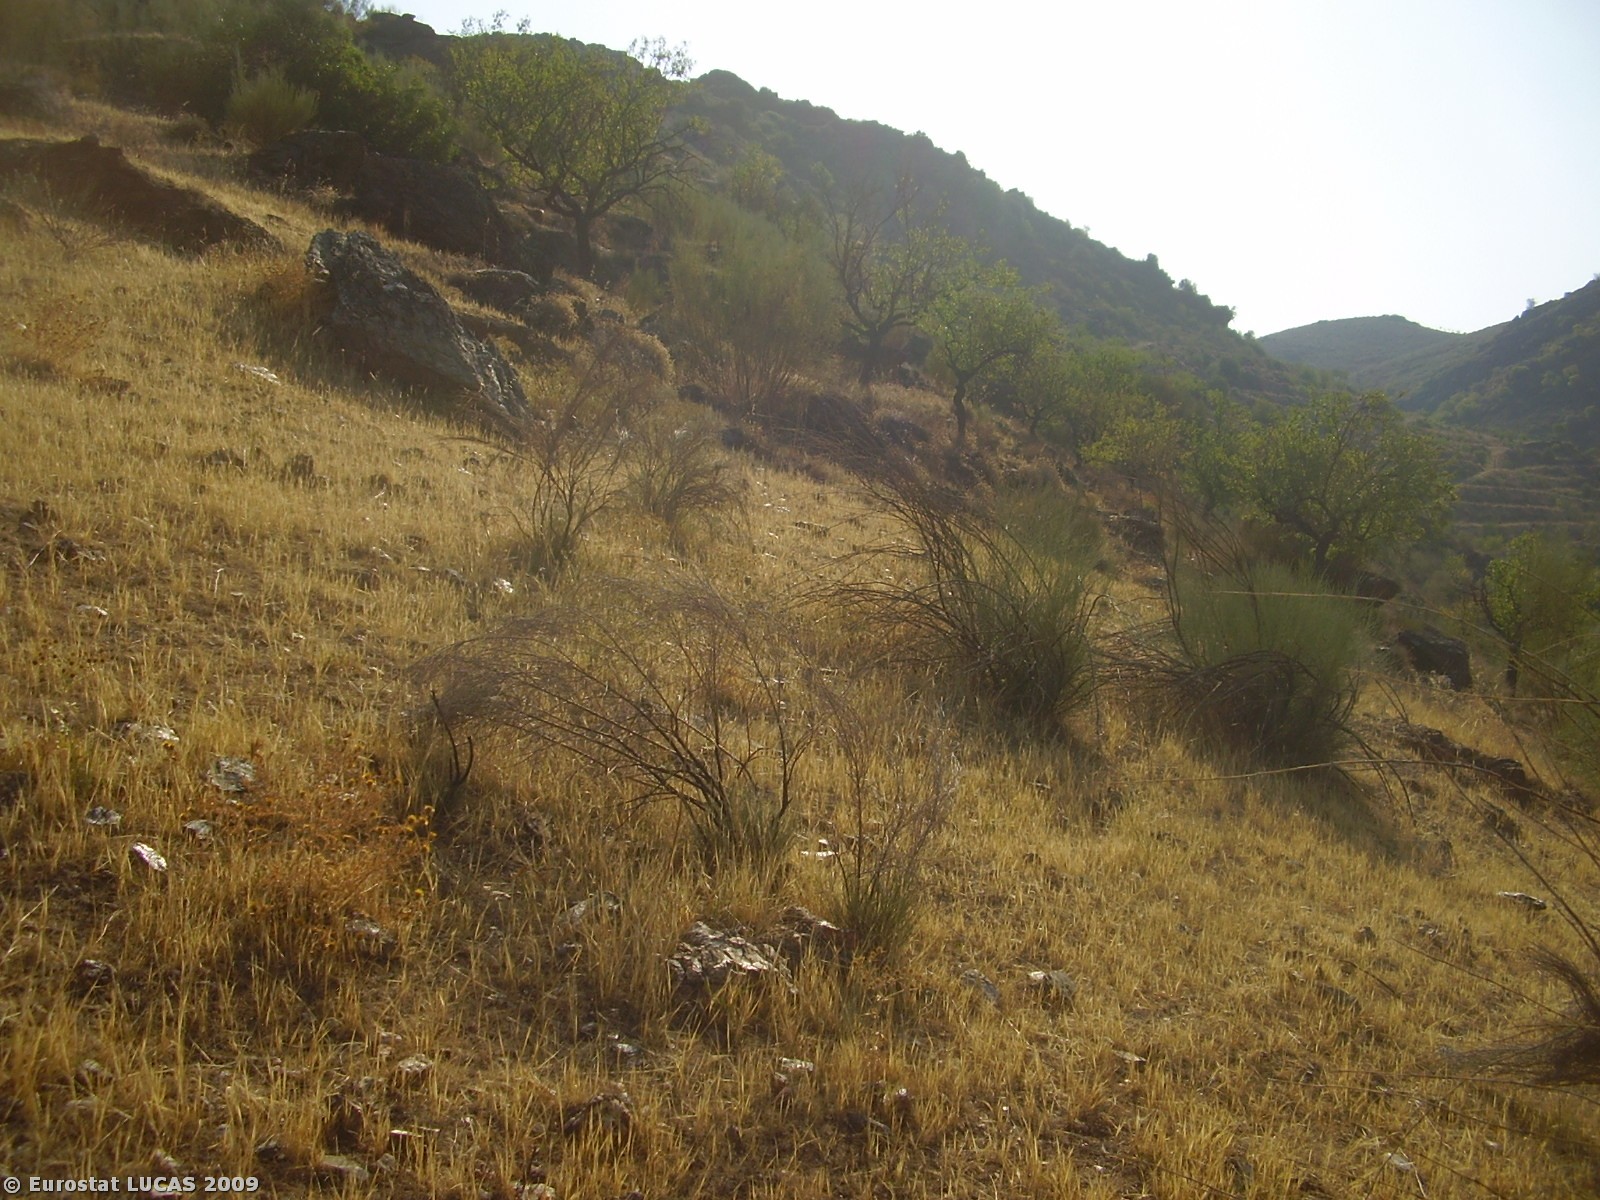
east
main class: Grassland
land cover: Spontaneously vegetated surfaces
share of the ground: > 75 %
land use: Fallow land
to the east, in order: Spontaneously vegetated surfaces; Nuts trees; Rock outcrops; Spontaneously vegetated surfaces
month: August
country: PT
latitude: 41.3301
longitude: -7.0193
